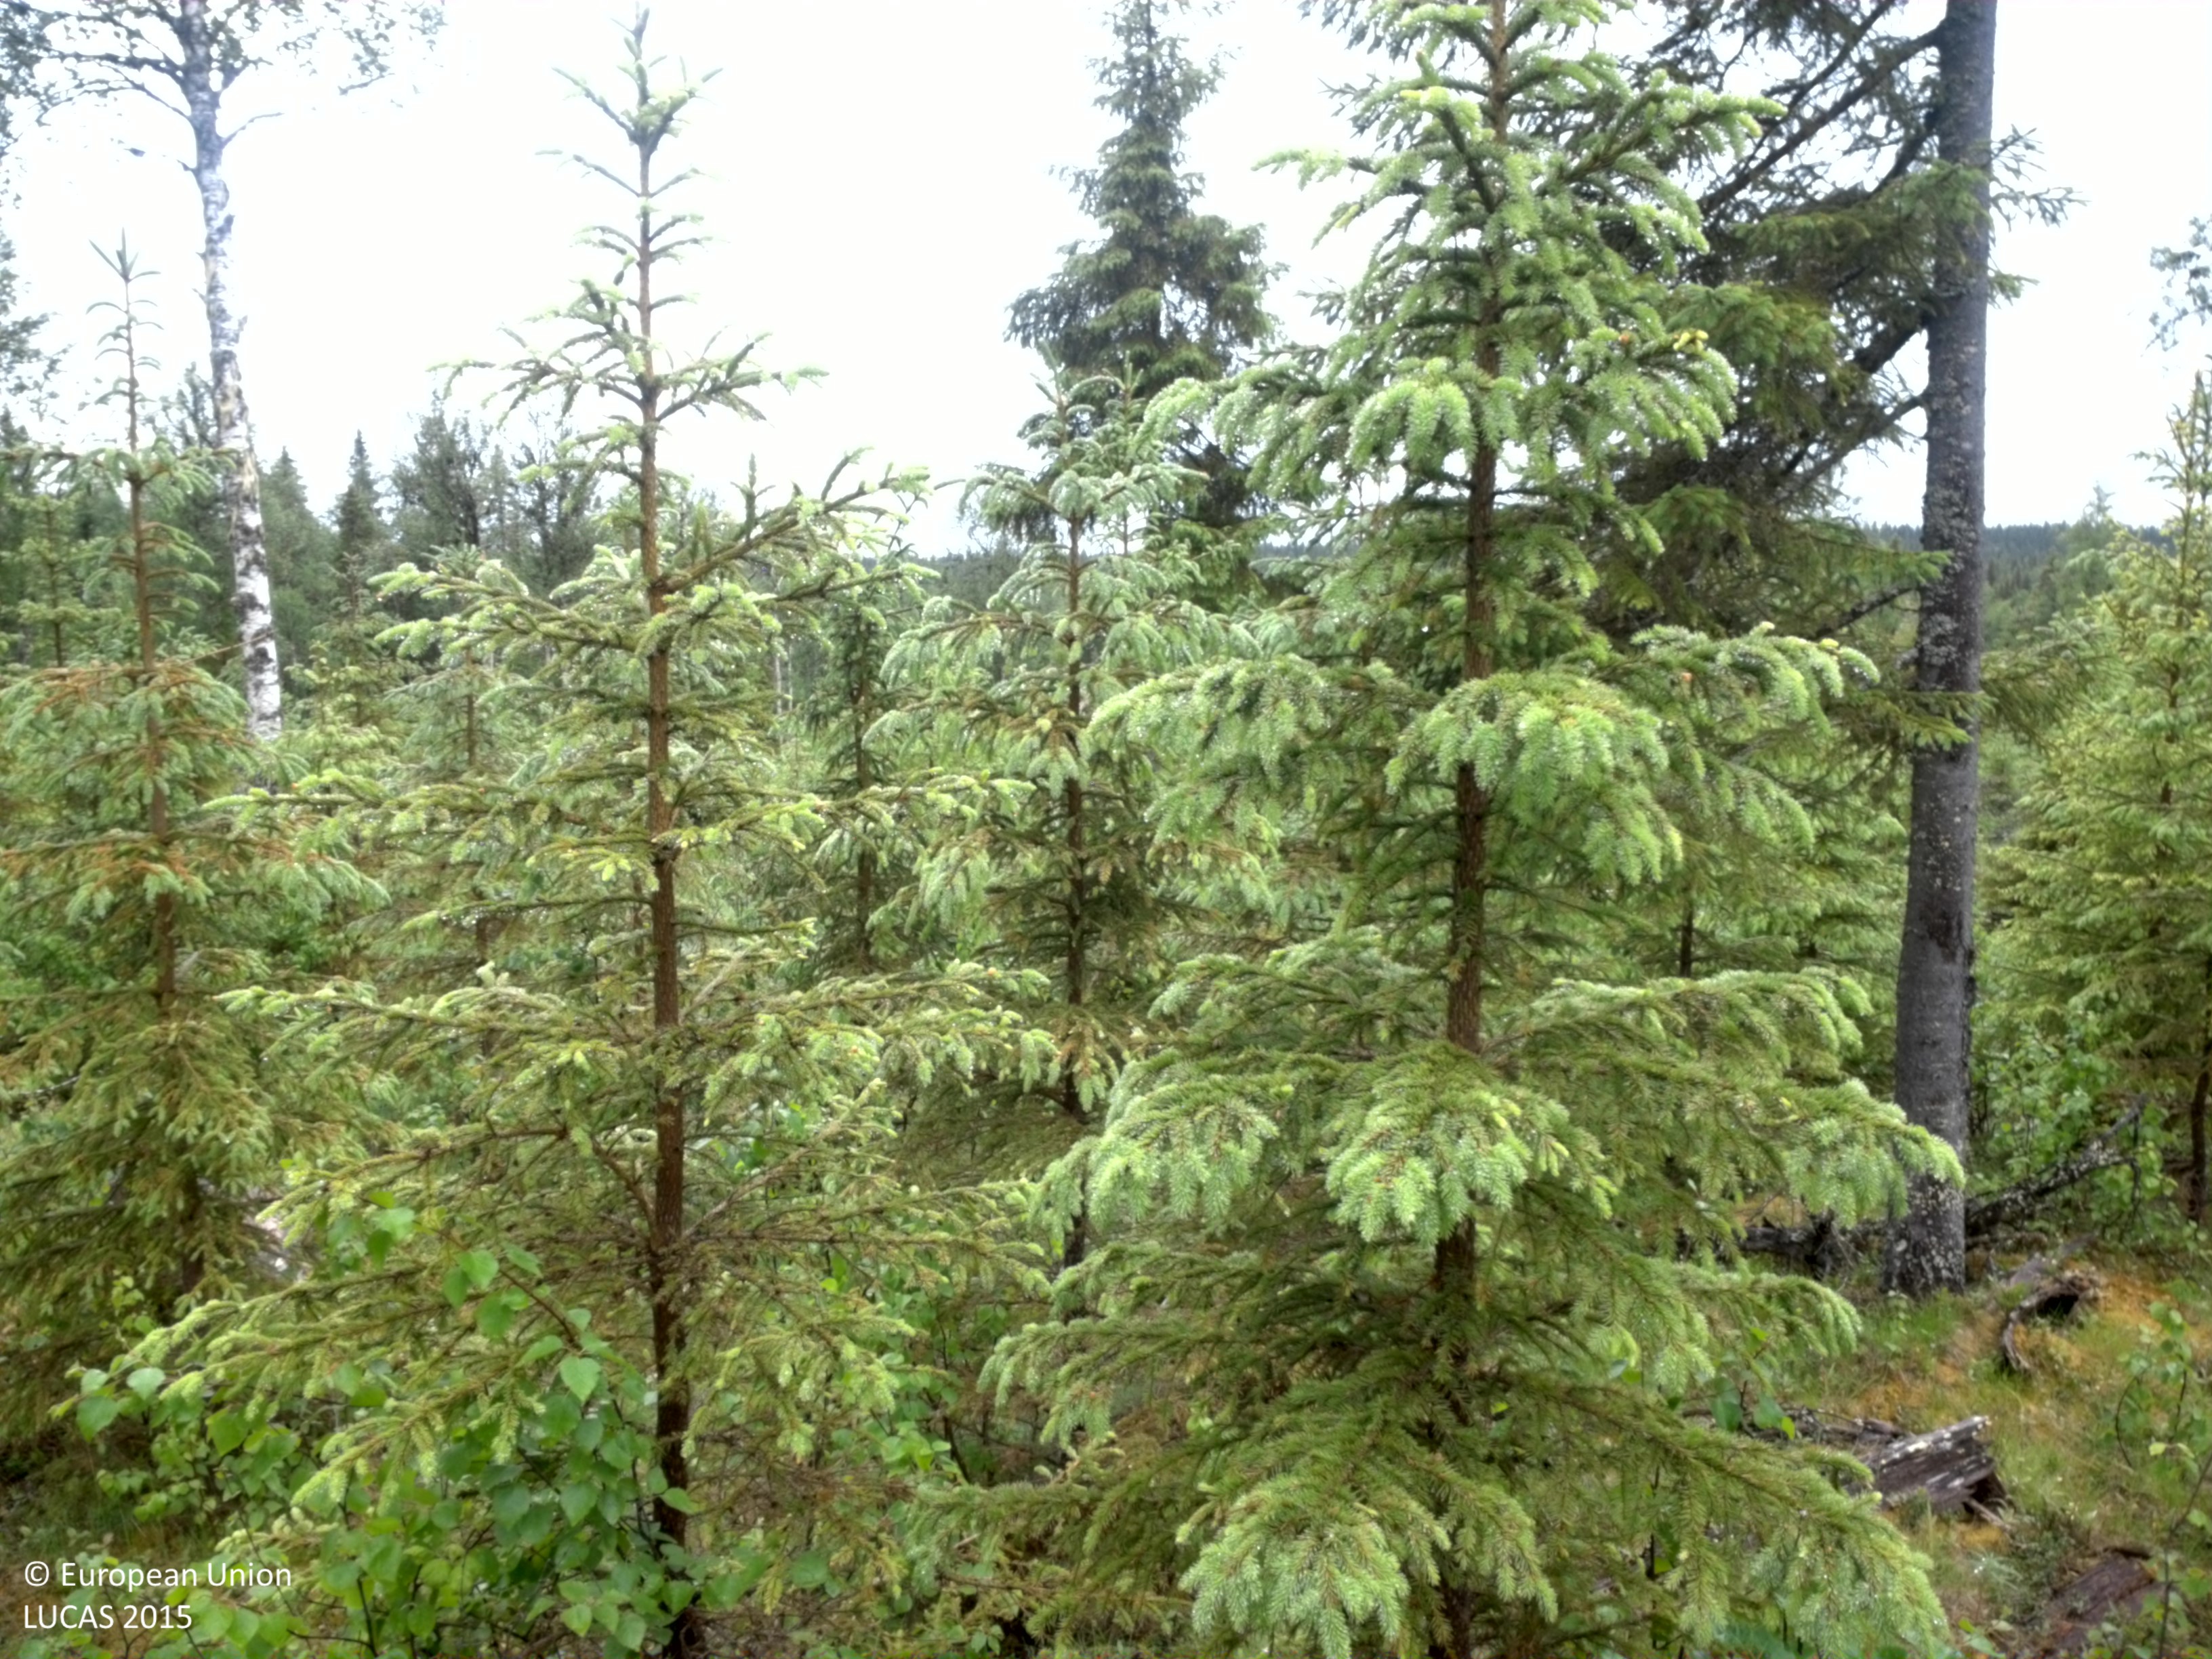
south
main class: Woodland
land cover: Spruce dominated mixed woodland
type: boreal forest
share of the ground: 50 - 75 %
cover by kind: coniferous forest trees 45 %, herbaceous plants 20 %, broadleaved forest trees 15 %, shrubs 15 %, lichens and mosses 5 %
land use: Forestry
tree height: > 5 m
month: July
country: SE
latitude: 64.3573
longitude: 18.3985
